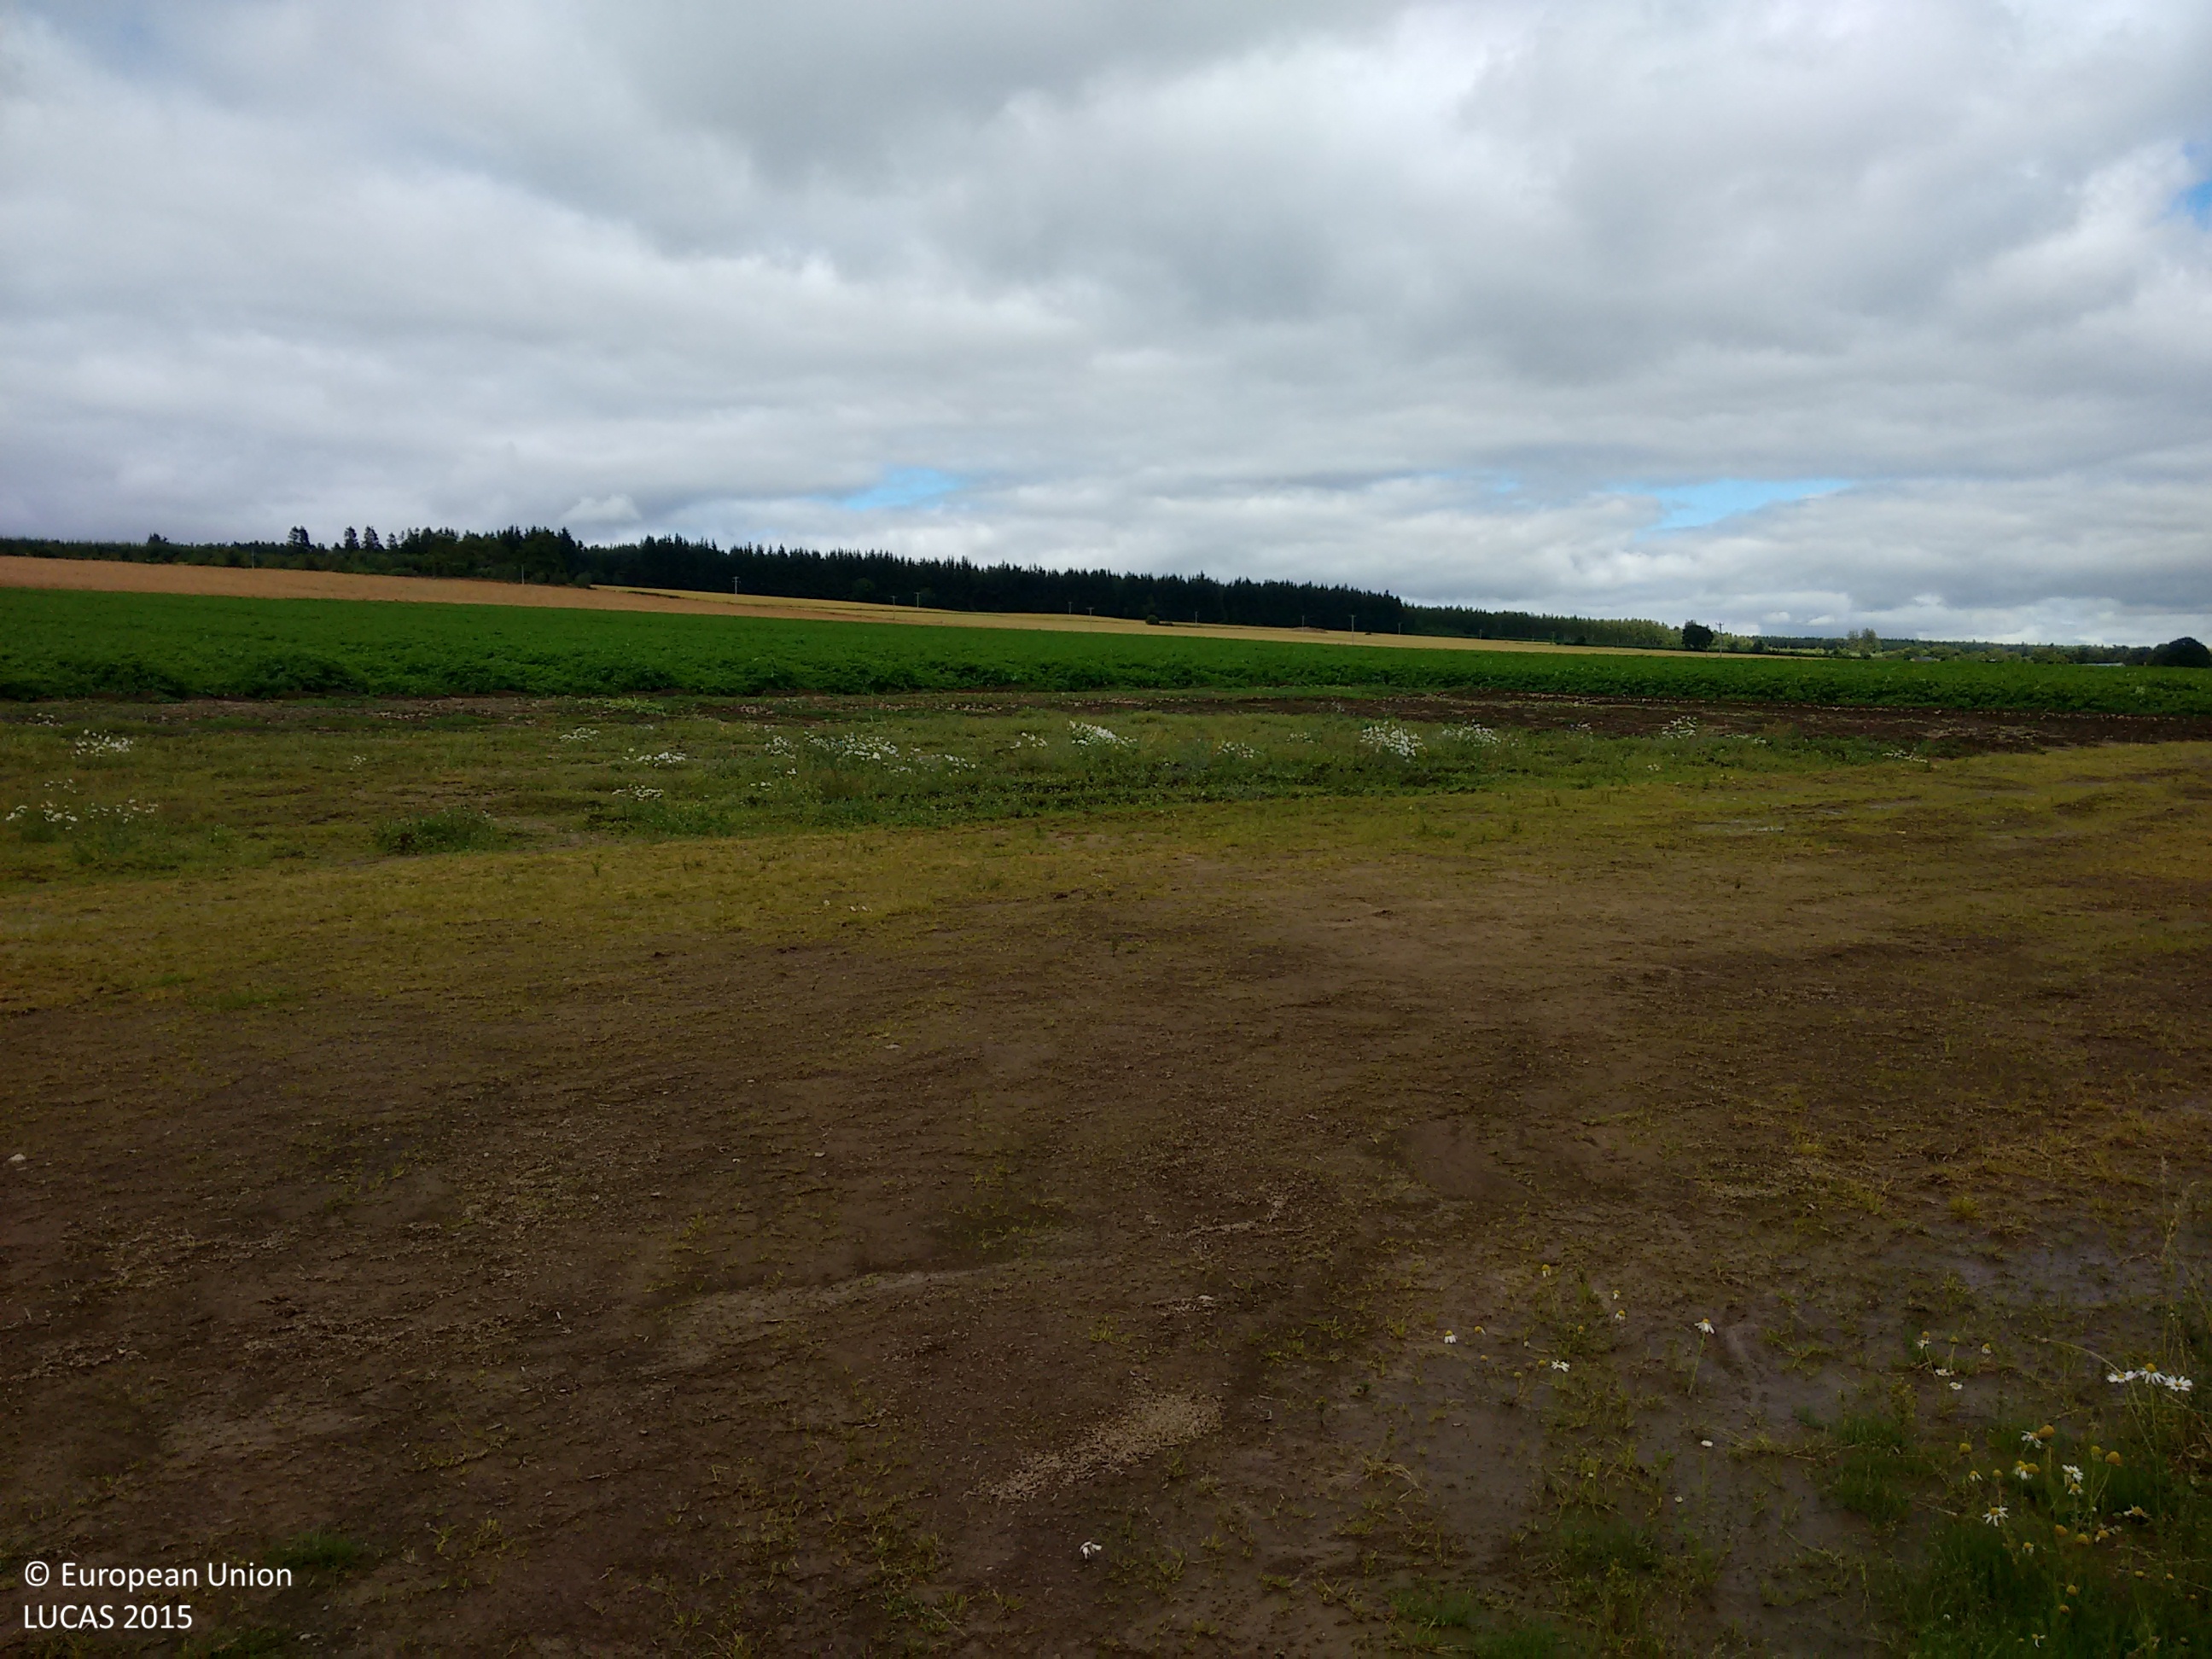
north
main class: Cropland
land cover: Potatoes
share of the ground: > 75 %
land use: Agriculture (excluding fallow land and kitchen gardens)
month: August
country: GB
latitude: 57.5827
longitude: -4.2513
